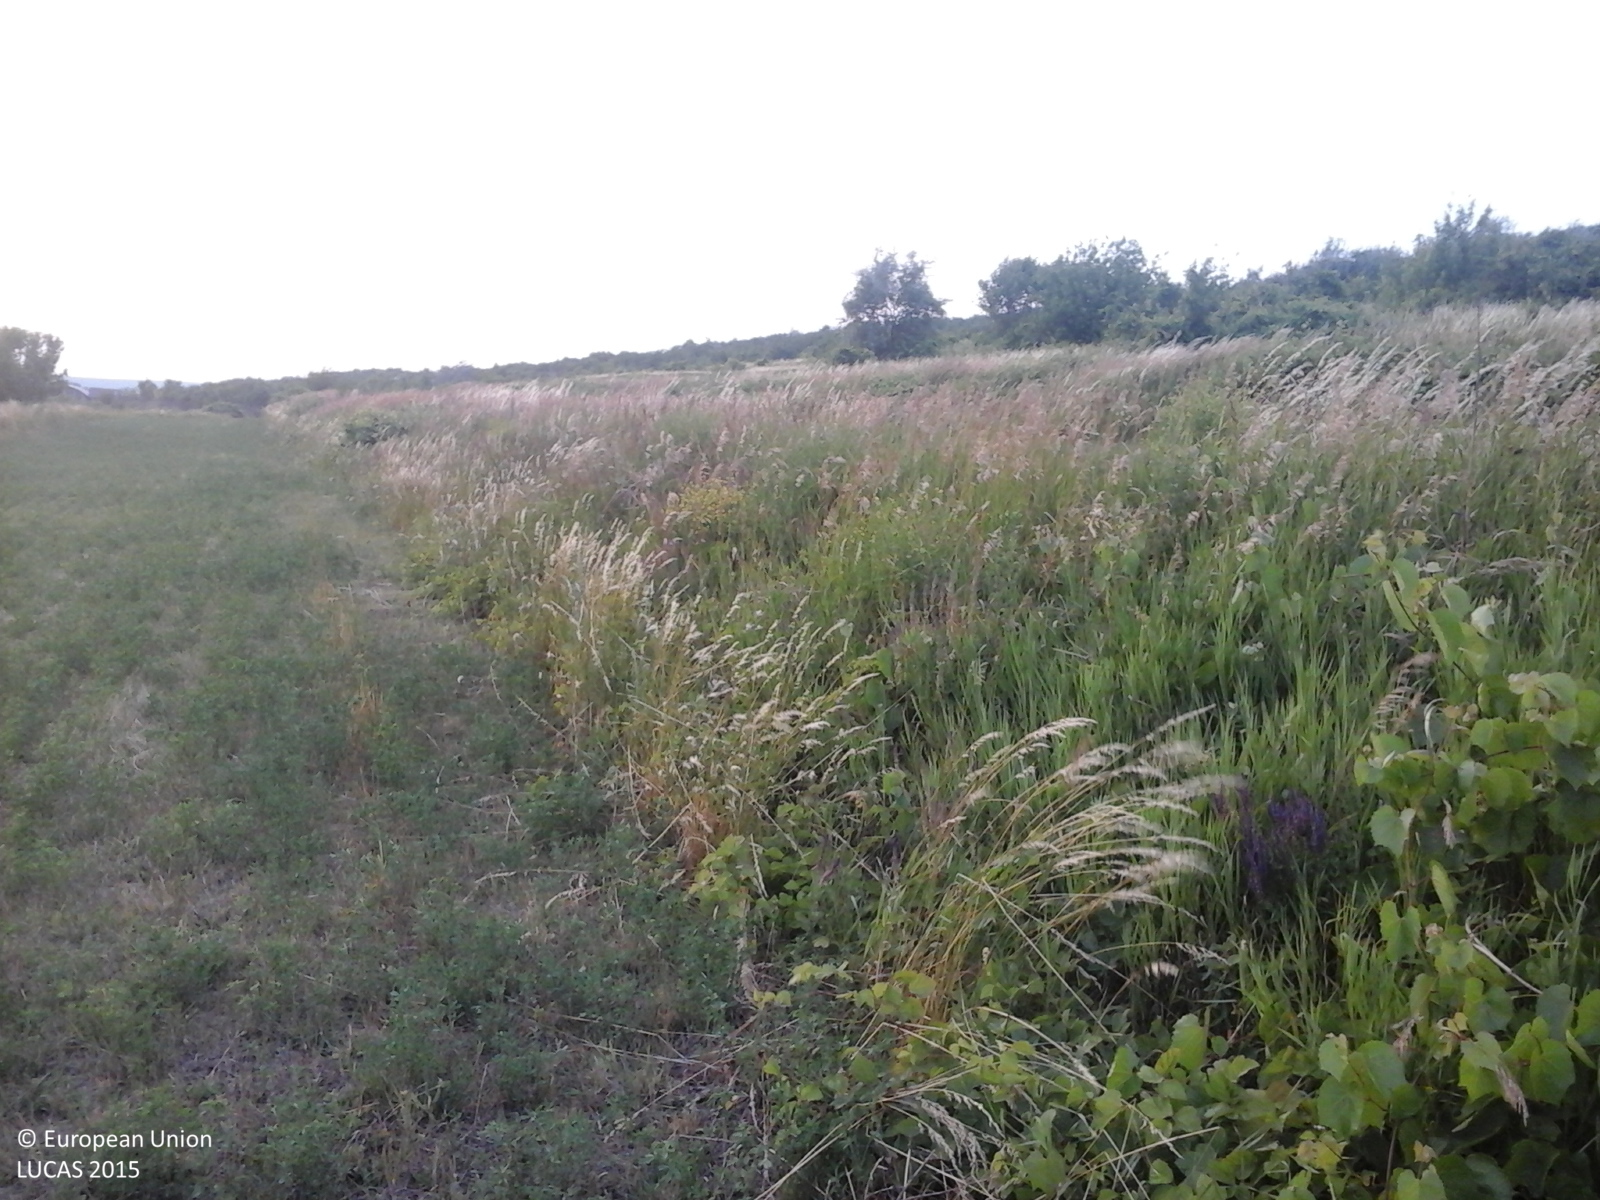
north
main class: Cropland
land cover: Lucerne
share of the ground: > 75 %
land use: Agriculture (excluding fallow land and kitchen gardens)
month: June
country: RO
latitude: 46.6657
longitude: 27.6972
